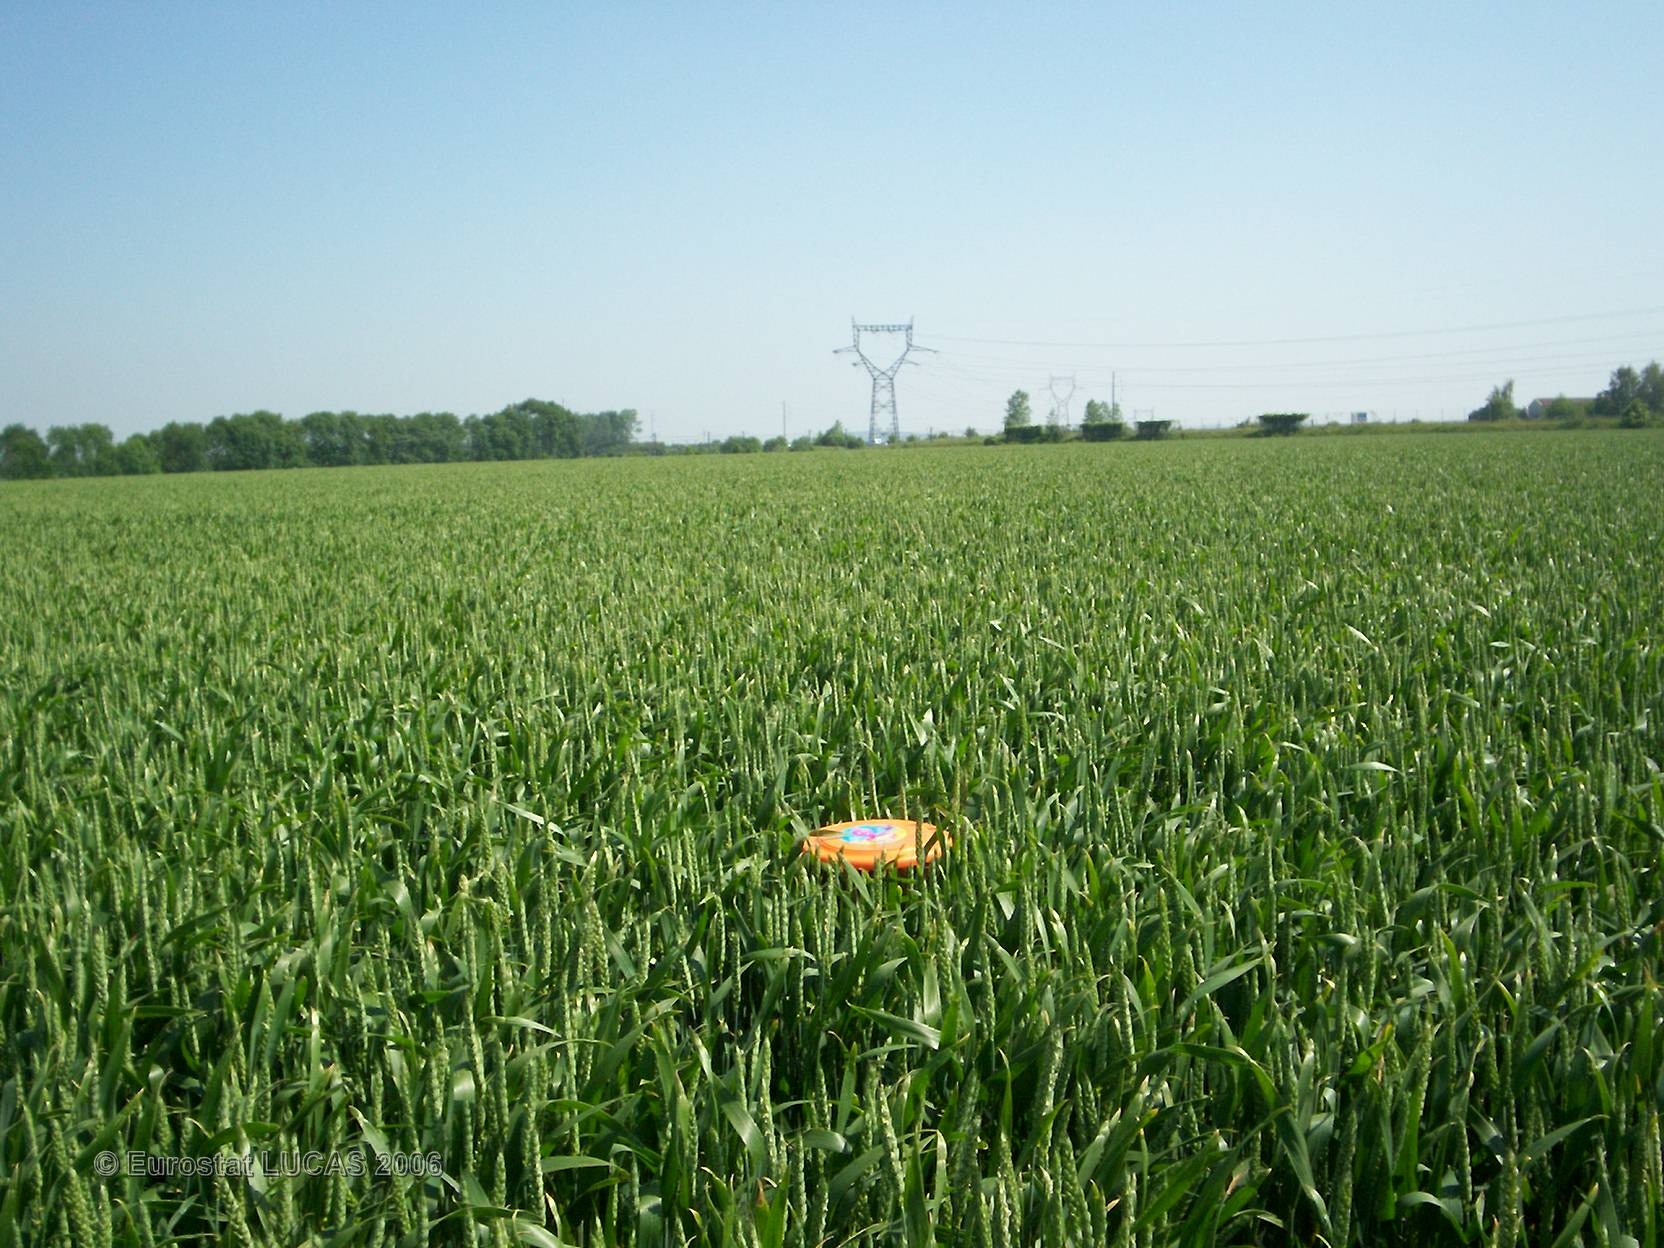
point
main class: Cropland
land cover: Common wheat
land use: Agriculture (excluding fallow land and kitchen gardens)
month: June
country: FR
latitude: 49.4995
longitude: 2.7124
